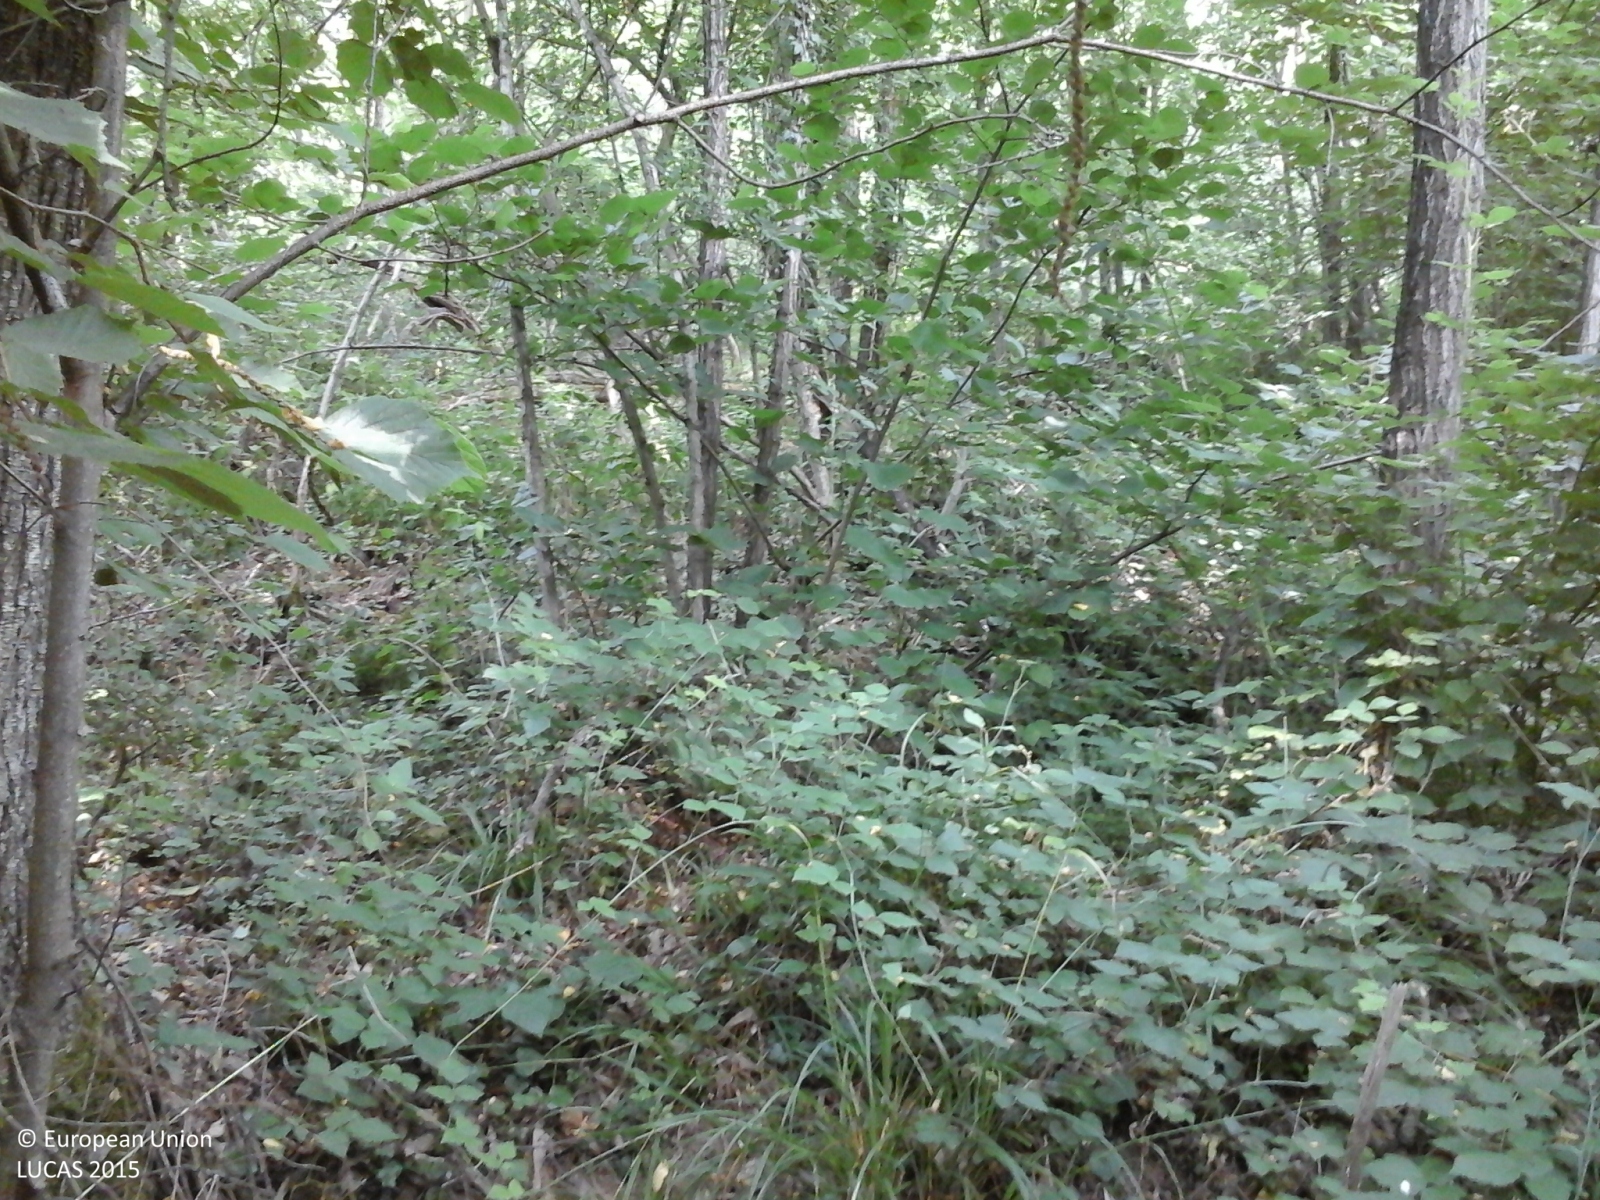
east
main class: Woodland
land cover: Broadleaved woodland
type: thermophilous deciduous forest
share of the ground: > 75 %
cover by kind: broadleaved forest trees 100 %
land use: Semi-natural and natural areas not in use
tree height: > 5 m
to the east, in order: Broadleaved woodland; Tracks; Broadleaved woodland
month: June
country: IT
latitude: 44.6855
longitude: 8.7283
